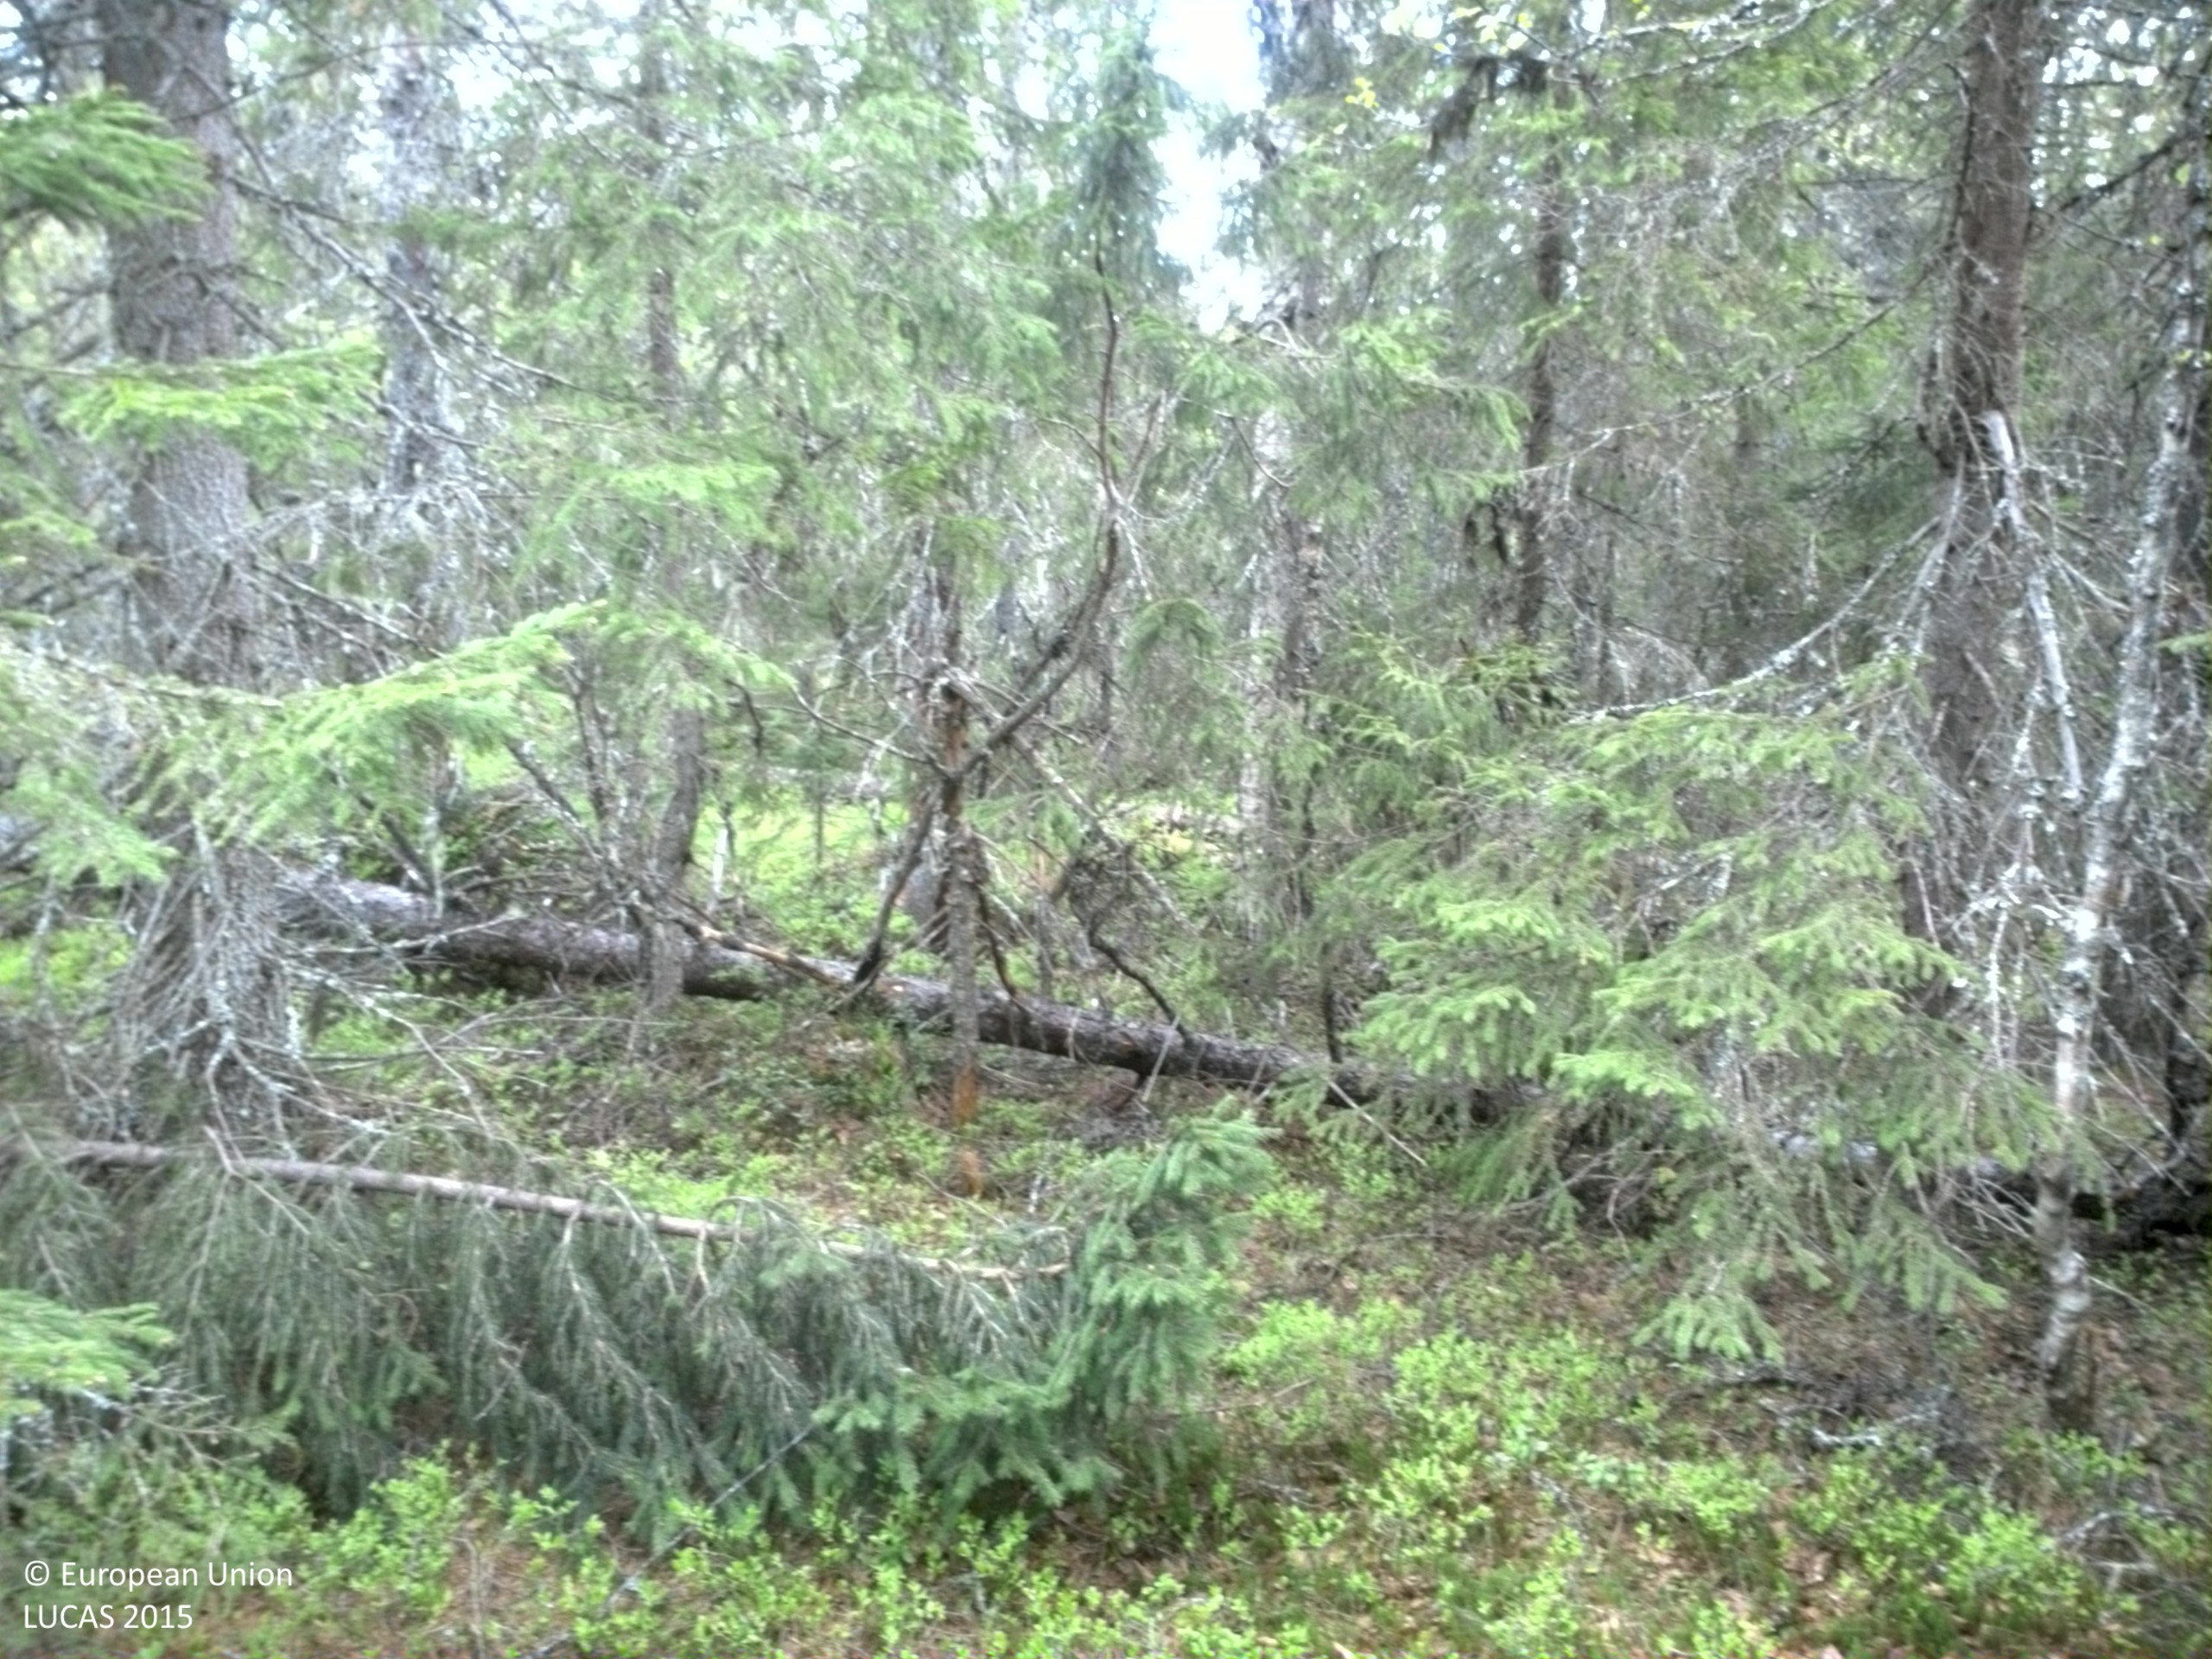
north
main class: Woodland
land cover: Spruce dominated coniferous woodland
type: boreal forest
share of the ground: 50 - 75 %
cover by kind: coniferous forest trees 60 %, shrubs 30 %, lichens and mosses 10 %
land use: Forestry
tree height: > 5 m
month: June
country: SE
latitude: 62.9234
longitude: 17.3225
